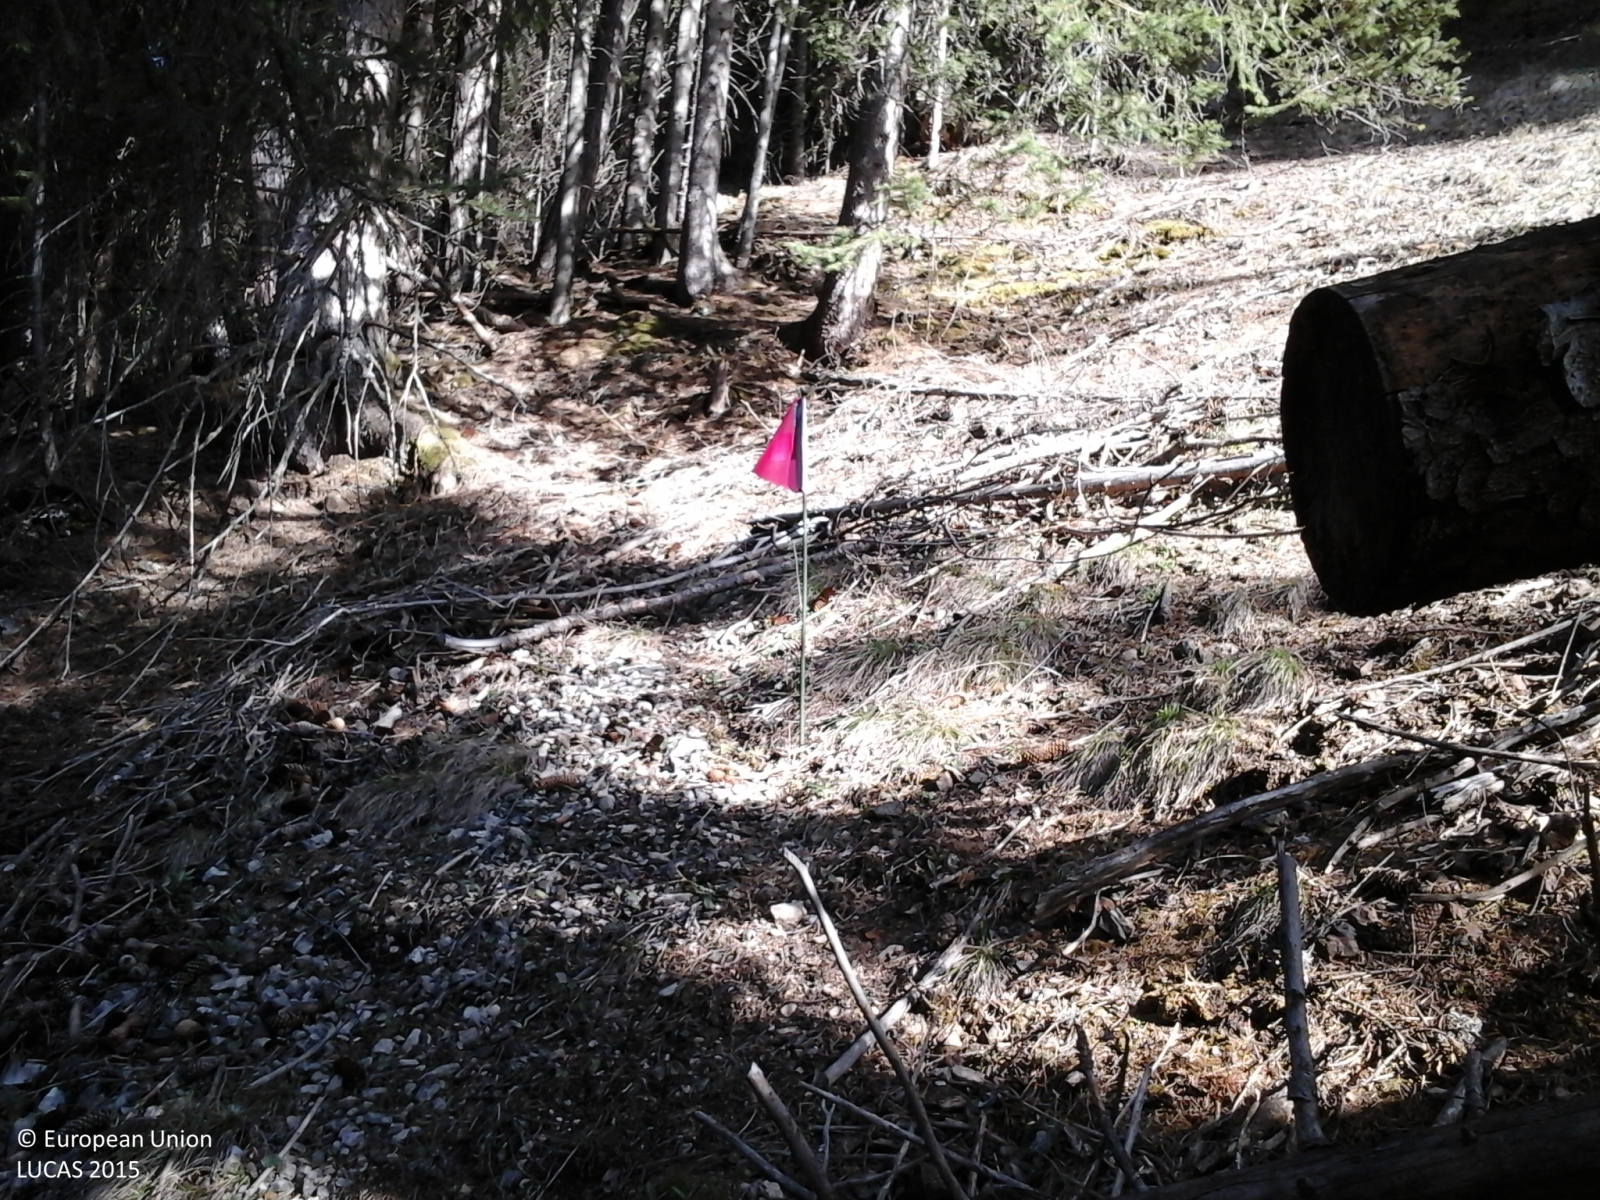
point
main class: Woodland
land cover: Spruce dominated coniferous woodland
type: alpine coniferous forest
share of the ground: > 75 %
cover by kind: coniferous forest trees 85 %, unconsolidated bare surface 10 %, herbaceous plants 5 %
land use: Forestry
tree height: > 5 m
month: May
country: IT
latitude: 46.4809
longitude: 11.7564
